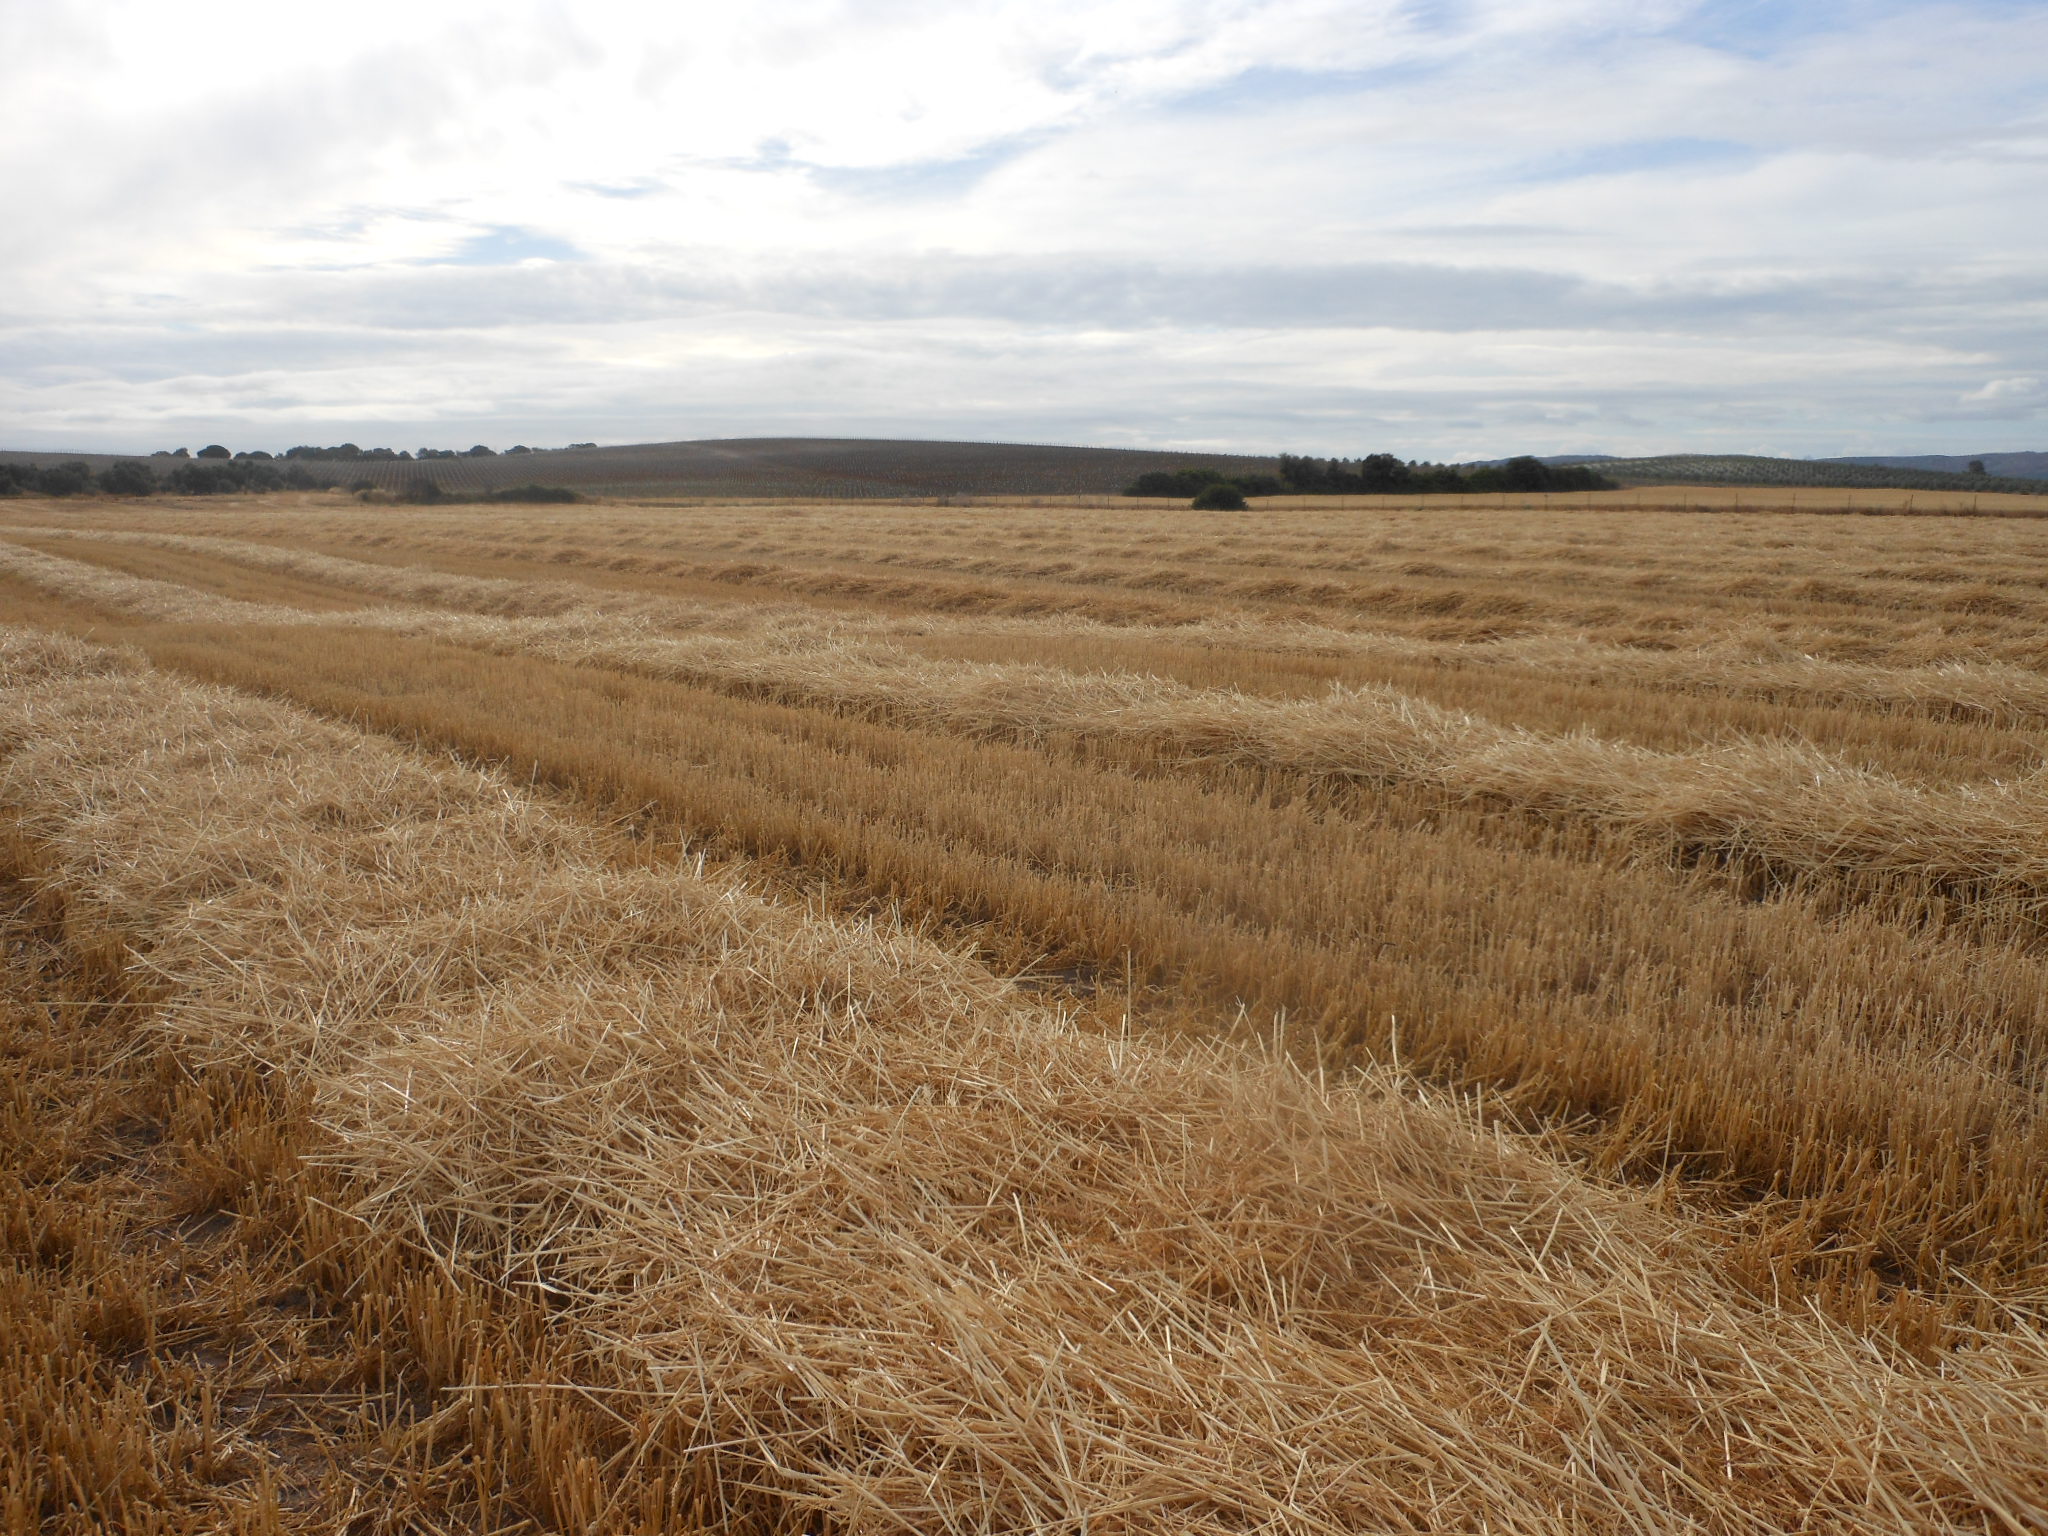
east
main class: Cropland
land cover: Common wheat
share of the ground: < 10 %
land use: Agriculture (excluding fallow land and kitchen gardens)
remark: Harvested field
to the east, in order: Common wheat
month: June
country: ES
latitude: 37.1939
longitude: -5.4570
